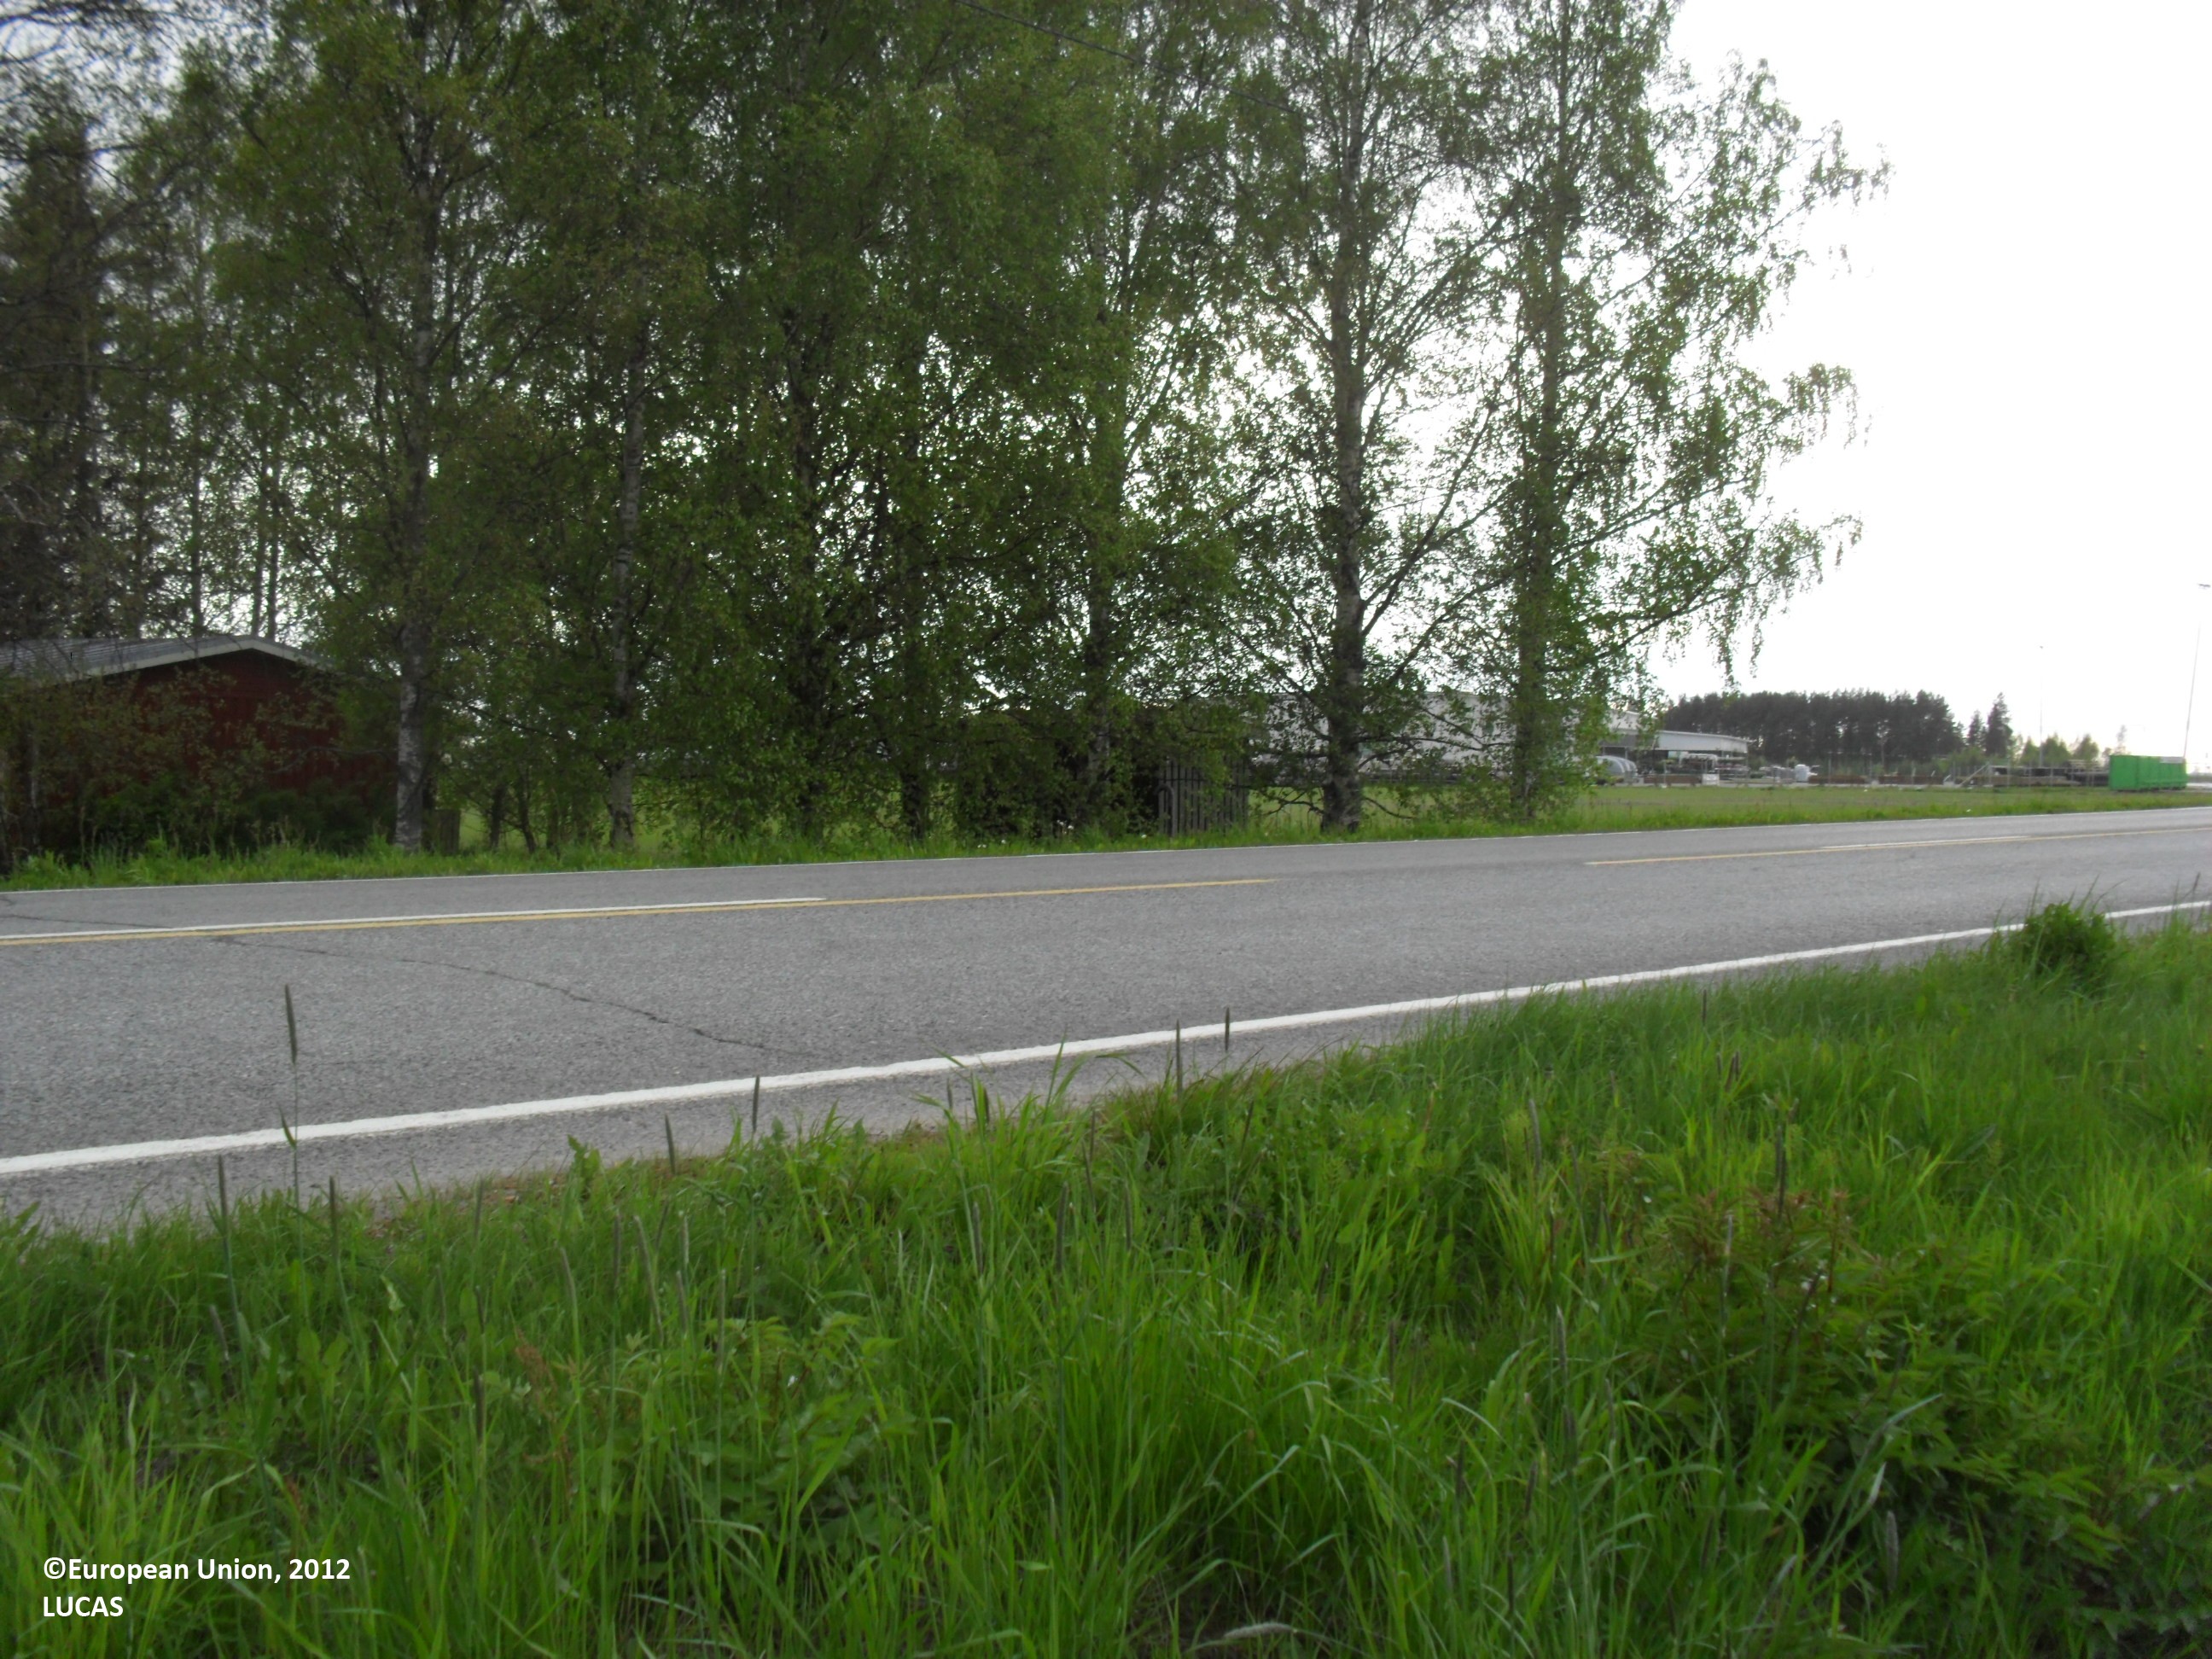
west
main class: Grassland
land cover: Grassland without tree/shrub cover
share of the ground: > 75 %
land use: Semi-natural and natural areas not in use
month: June
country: FI
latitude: 62.9785
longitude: 23.0213
